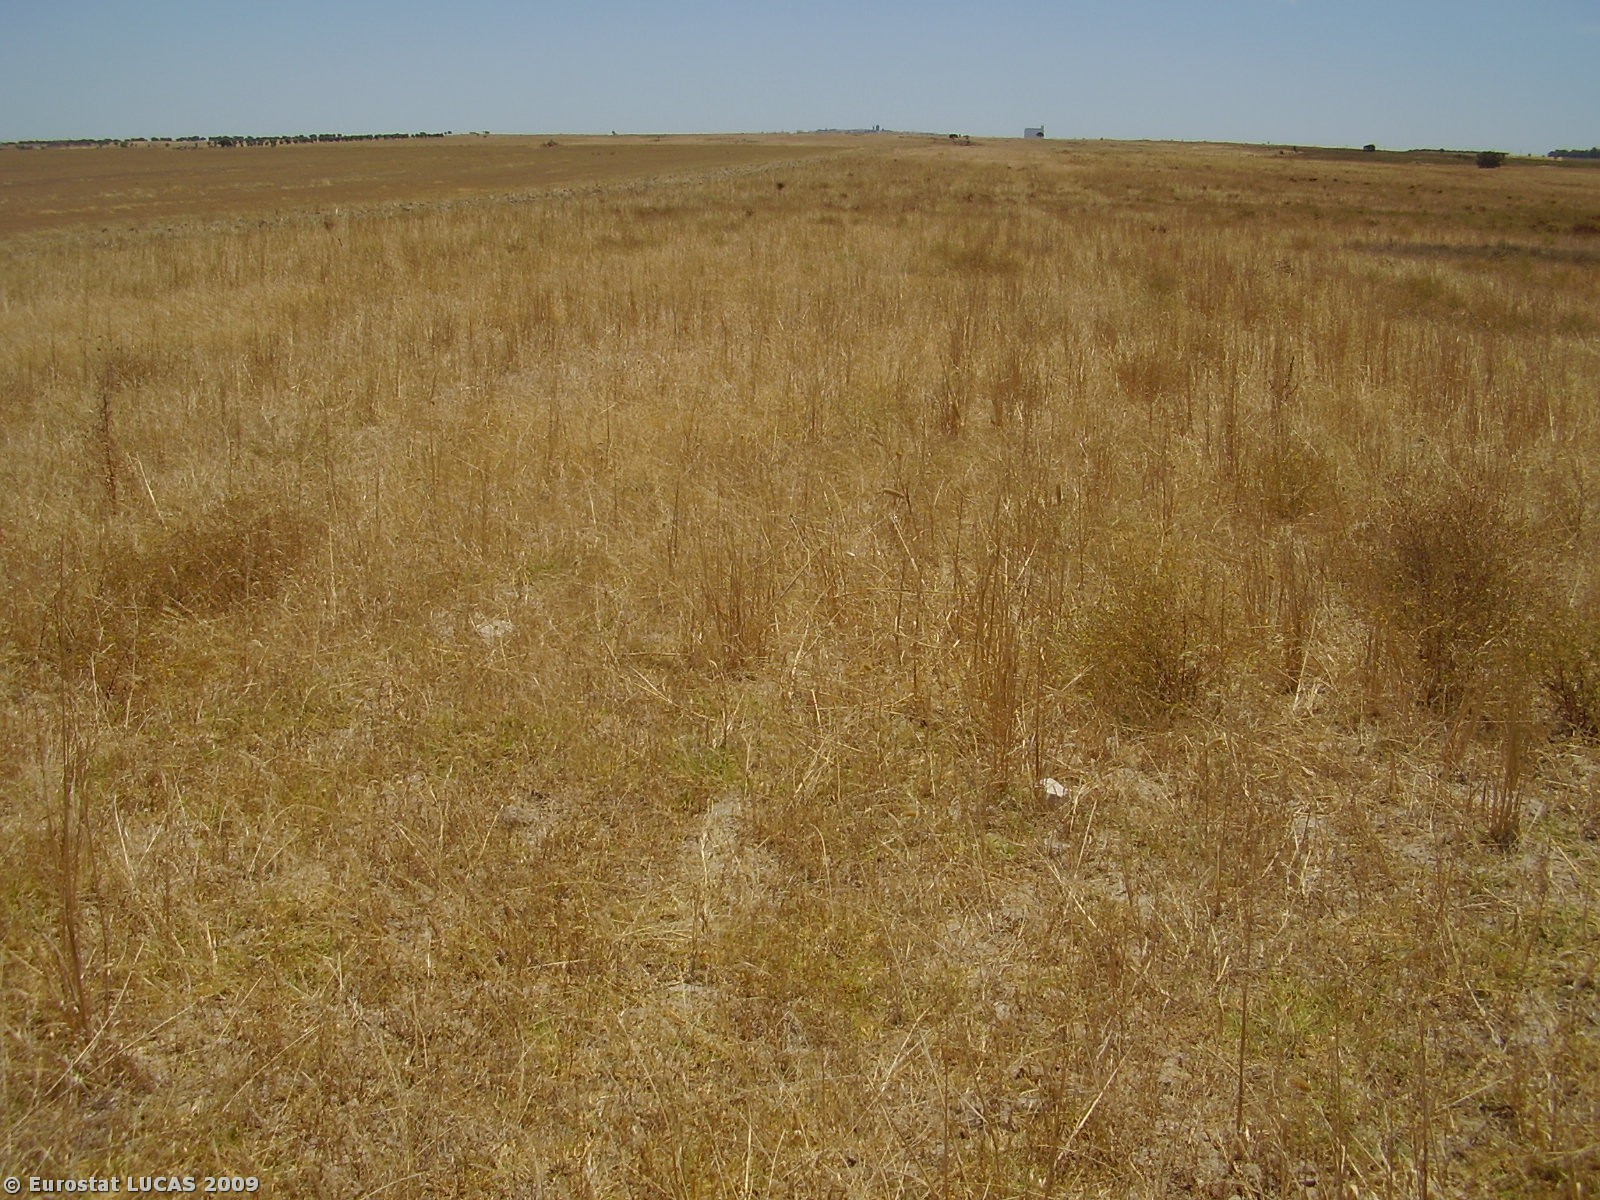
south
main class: Cropland
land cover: Oats
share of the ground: > 75 %
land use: Agriculture (excluding fallow land and kitchen gardens)
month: August
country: PT
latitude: 38.0973
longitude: -7.8520
